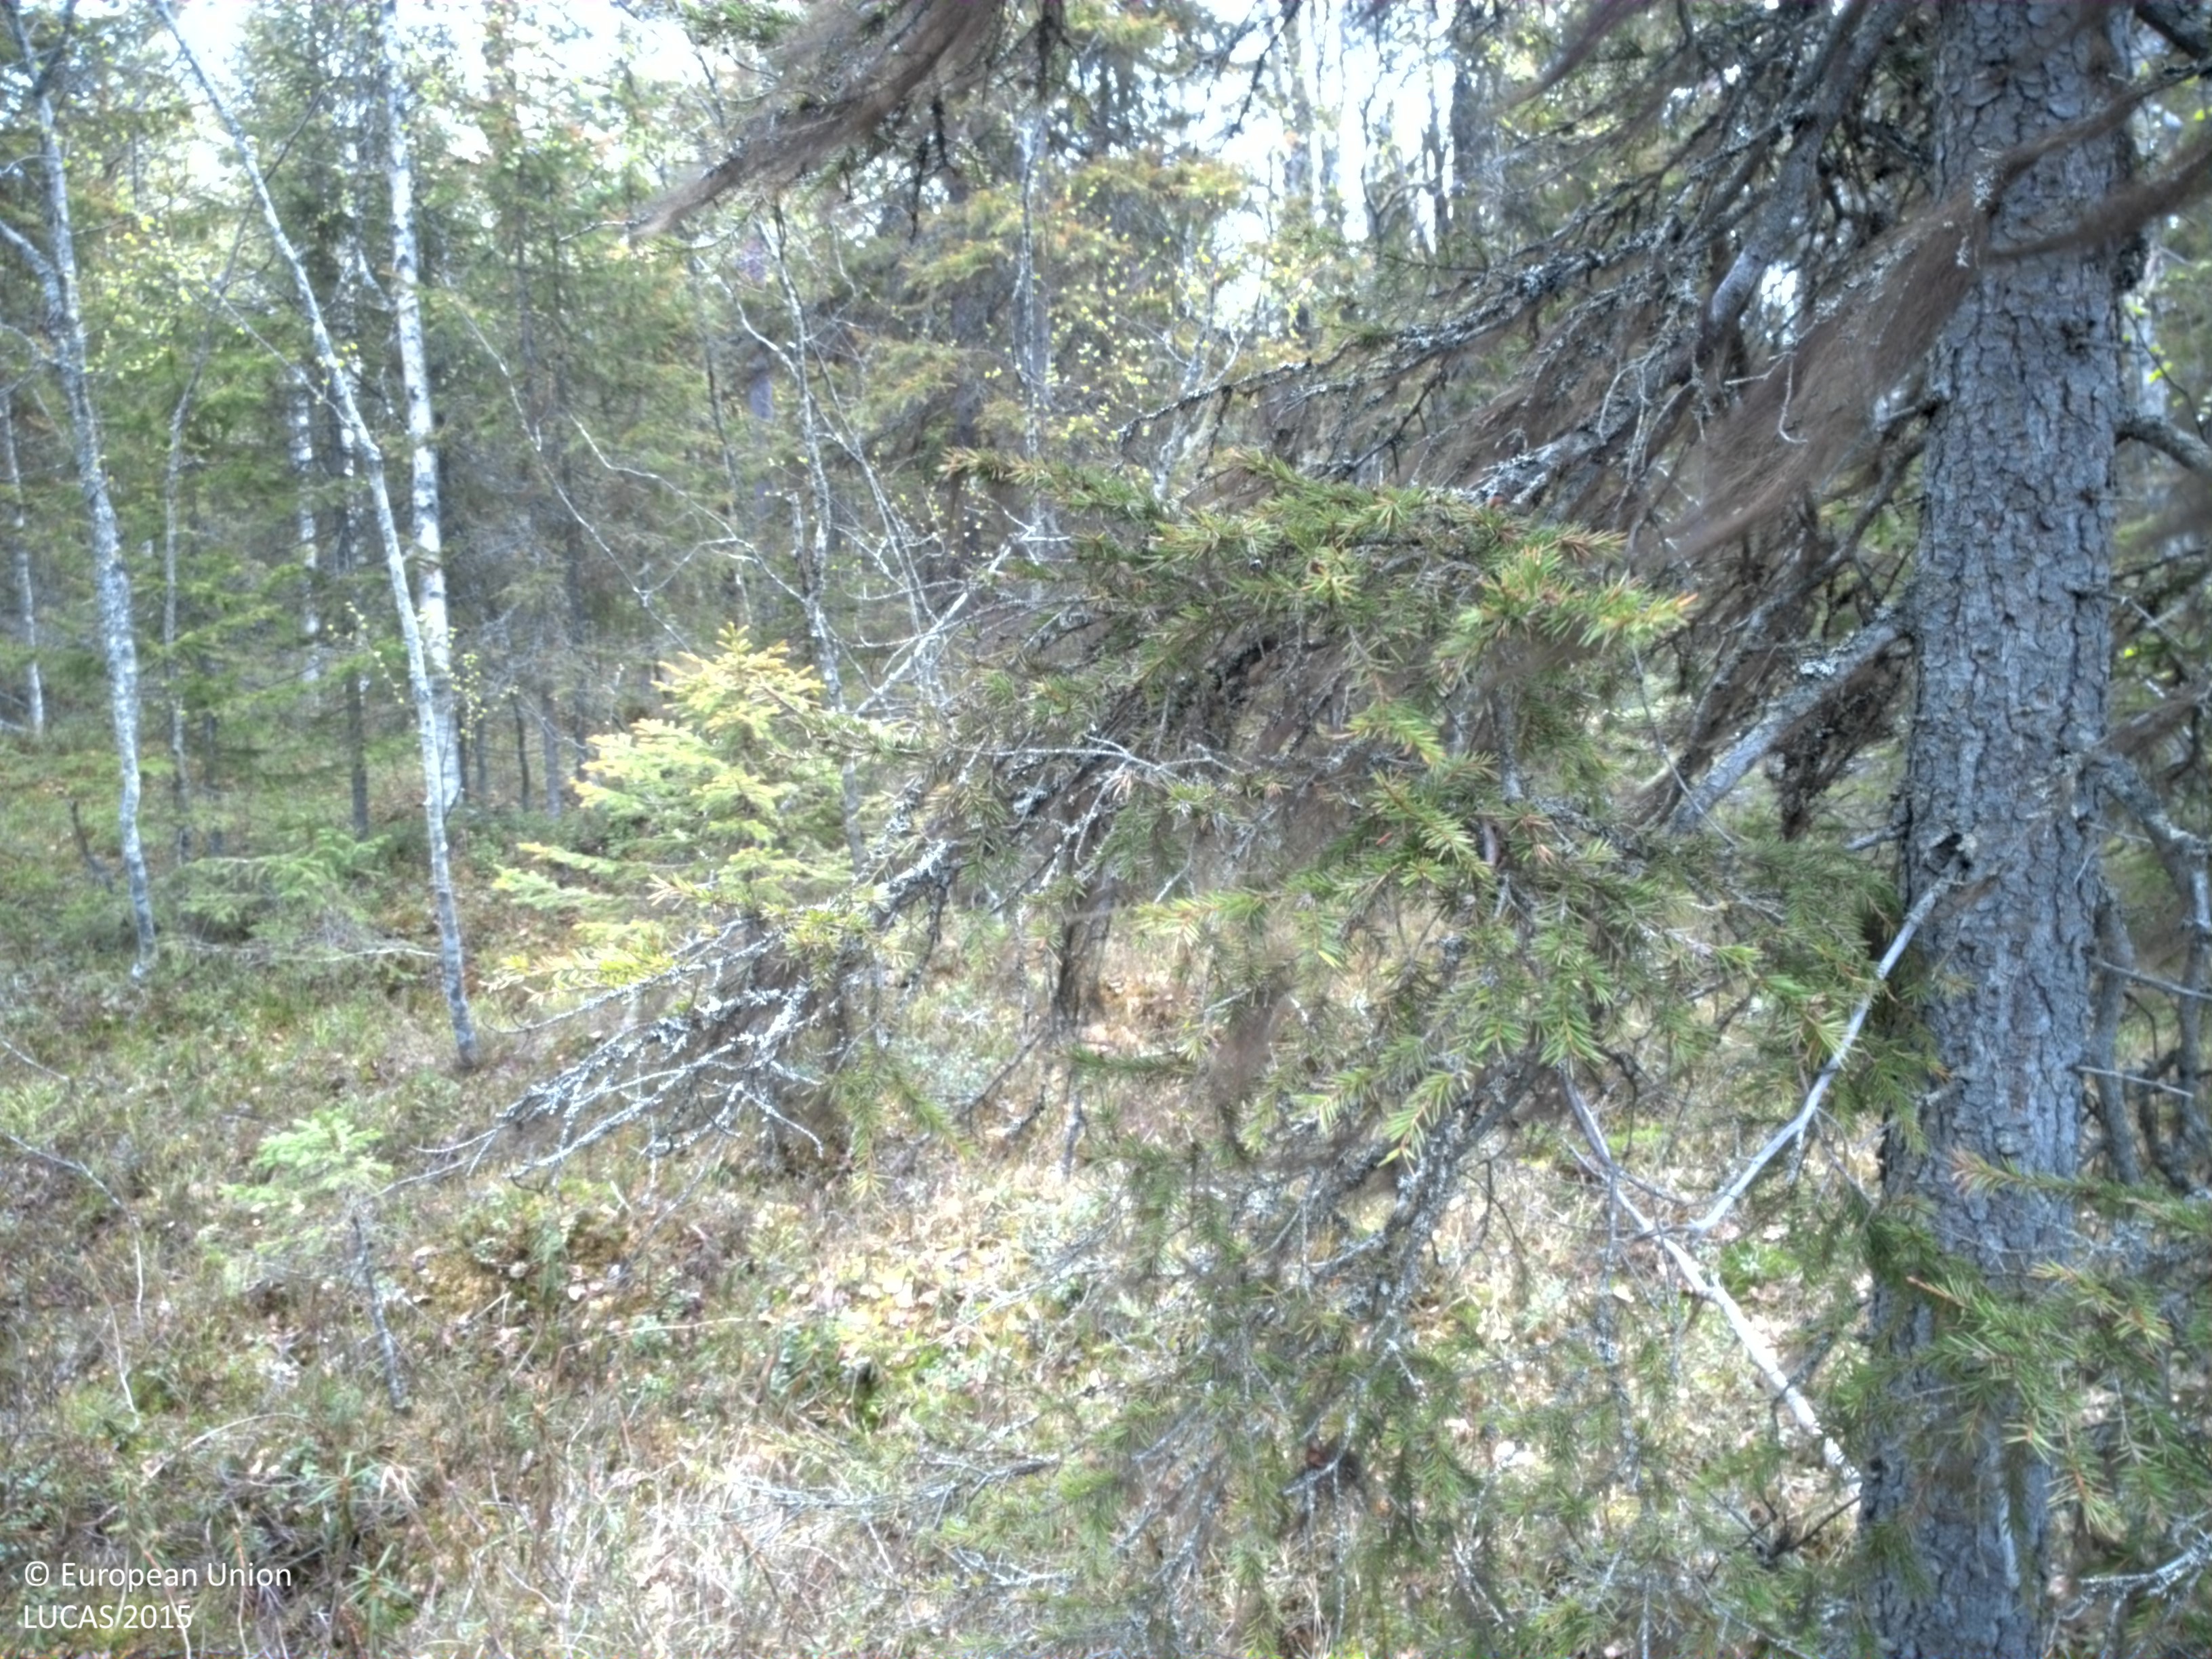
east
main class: Woodland
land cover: Spruce dominated mixed woodland
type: boreal forest
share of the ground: 50 - 75 %
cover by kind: coniferous forest trees 50 %, broadleaved forest trees 25 %, shrubs 25 %
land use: Forestry
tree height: > 5 m
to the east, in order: Spruce dominated mixed woodland; Ditches and canals; Tracks; Spruce dominated mixed woodland; Ditches and canals; Spruce dominated mixed woodland; Ditches and canals; Spruce dominated mixed woodland
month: June
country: SE
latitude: 66.4735
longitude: 23.4311
